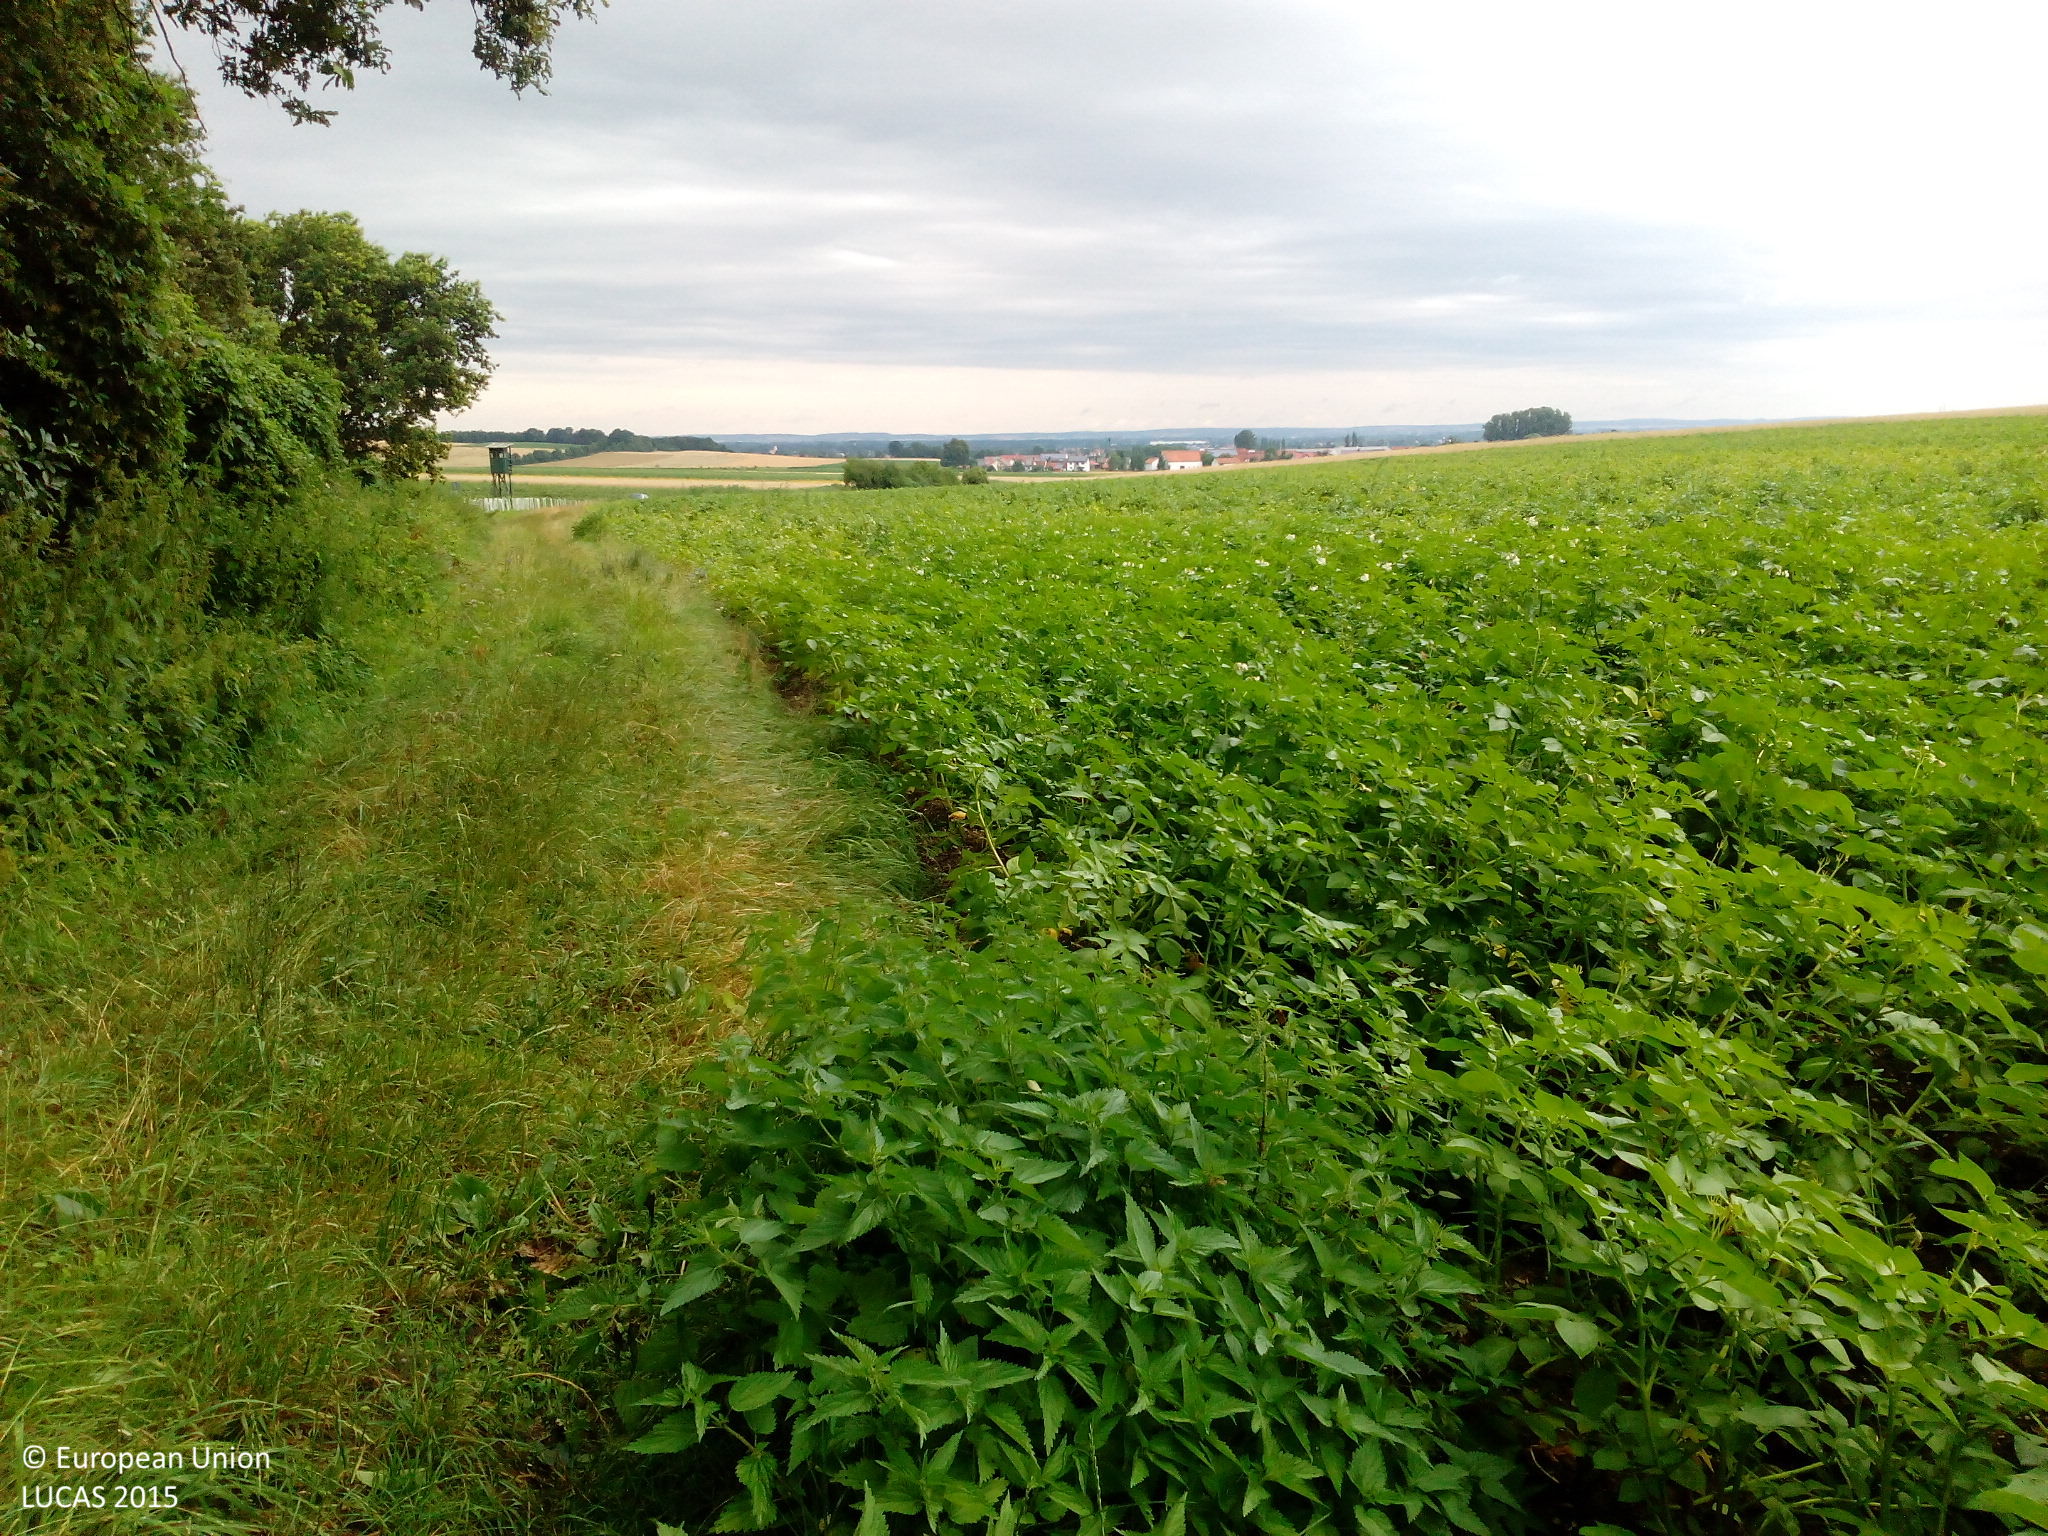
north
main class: Cropland
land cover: Potatoes
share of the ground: > 75 %
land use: Agriculture (excluding fallow land and kitchen gardens)
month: July
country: DE
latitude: 48.6463
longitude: 11.4245
